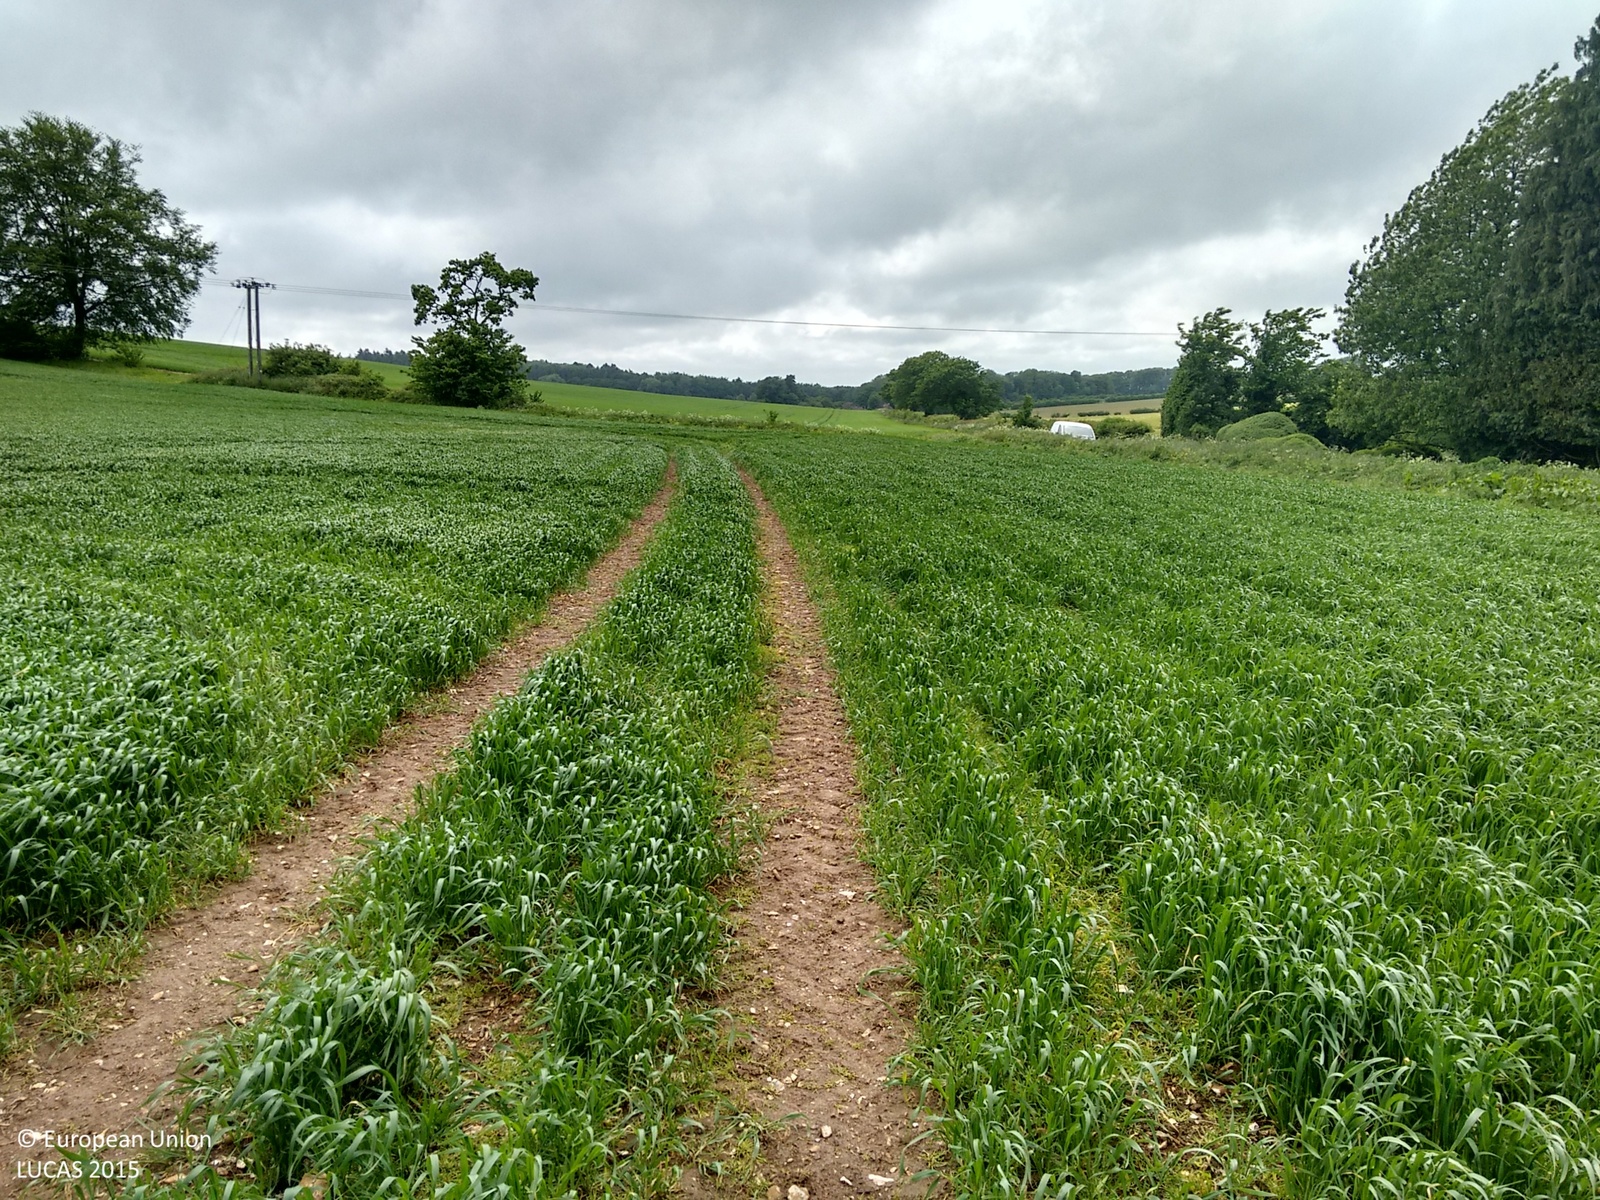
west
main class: Cropland
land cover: Common wheat
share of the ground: 50 - 75 %
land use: Agriculture (excluding fallow land and kitchen gardens)
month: June
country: GB
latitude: 51.0357
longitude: -1.1266
